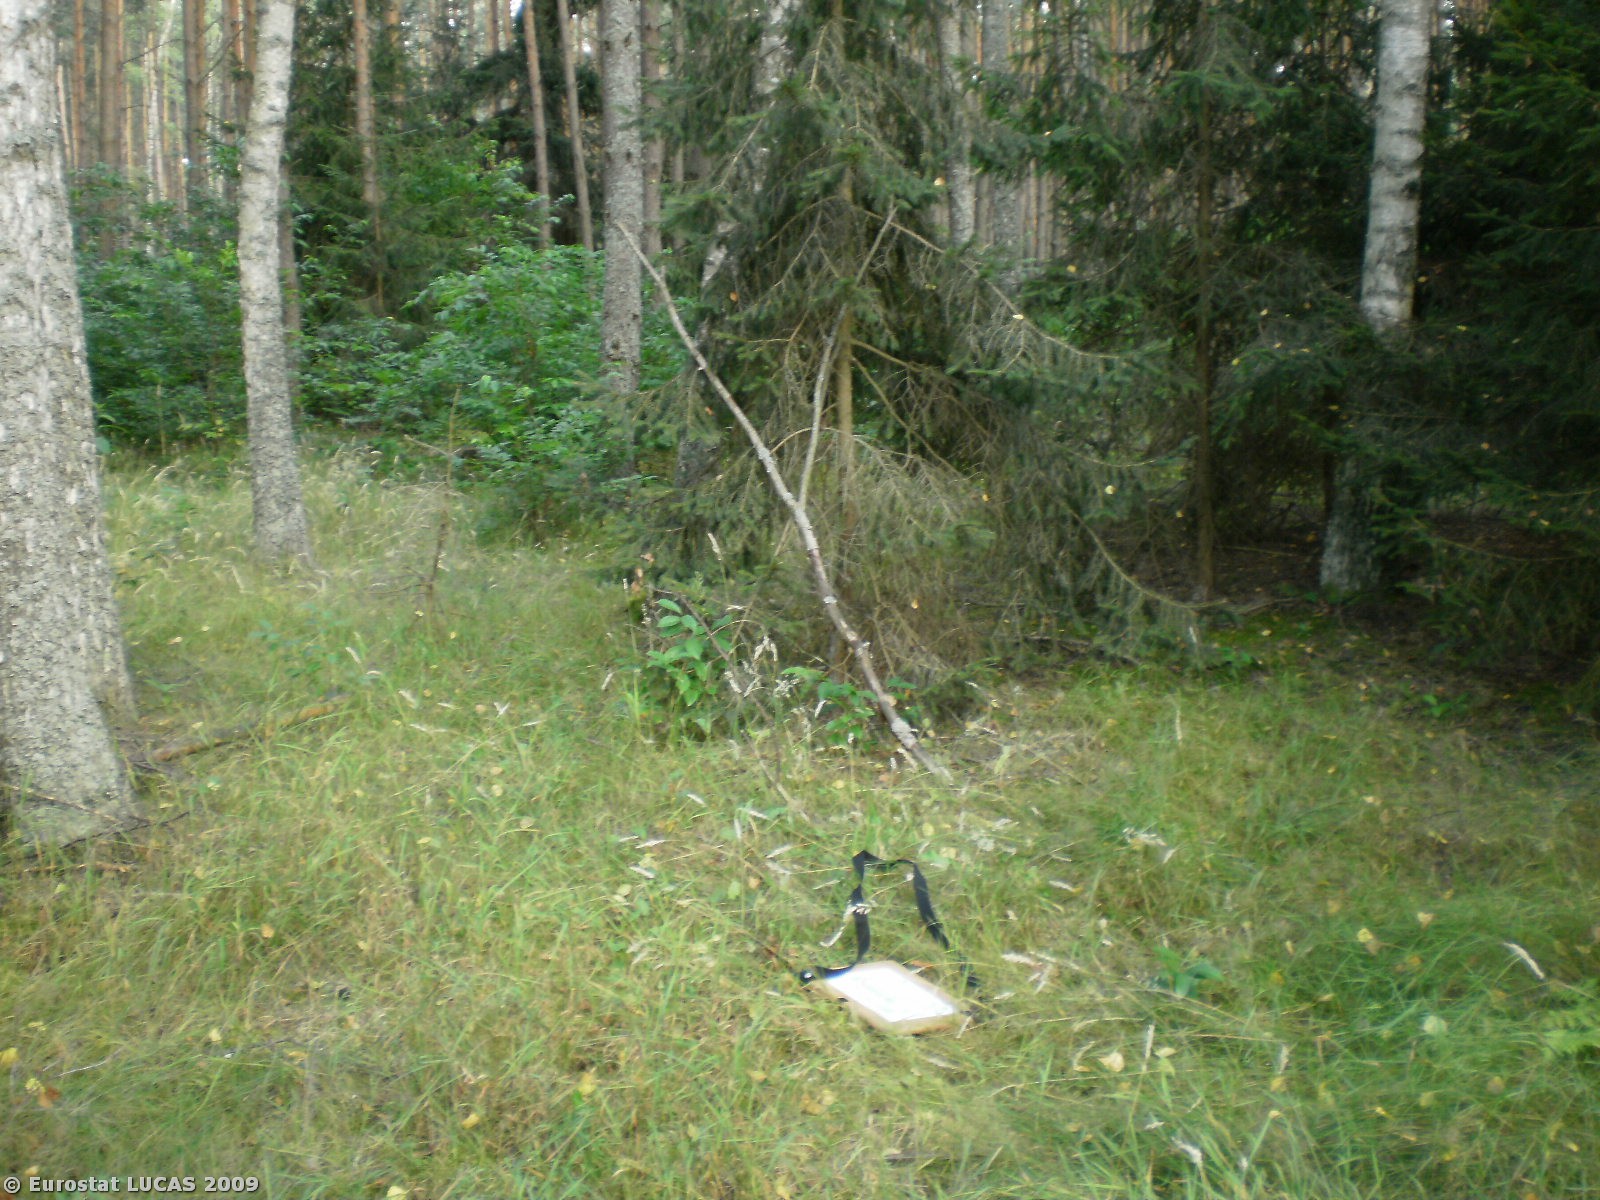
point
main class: Woodland
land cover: Mixed woodland
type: hemiboreal forest and nemoral coniferous forest and mixed broadleaved-coniferous forest
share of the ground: > 75 %
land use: Forestry
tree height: > 5 m
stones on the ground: < 10 %
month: July
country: PL
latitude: 53.3533
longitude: 20.9957
